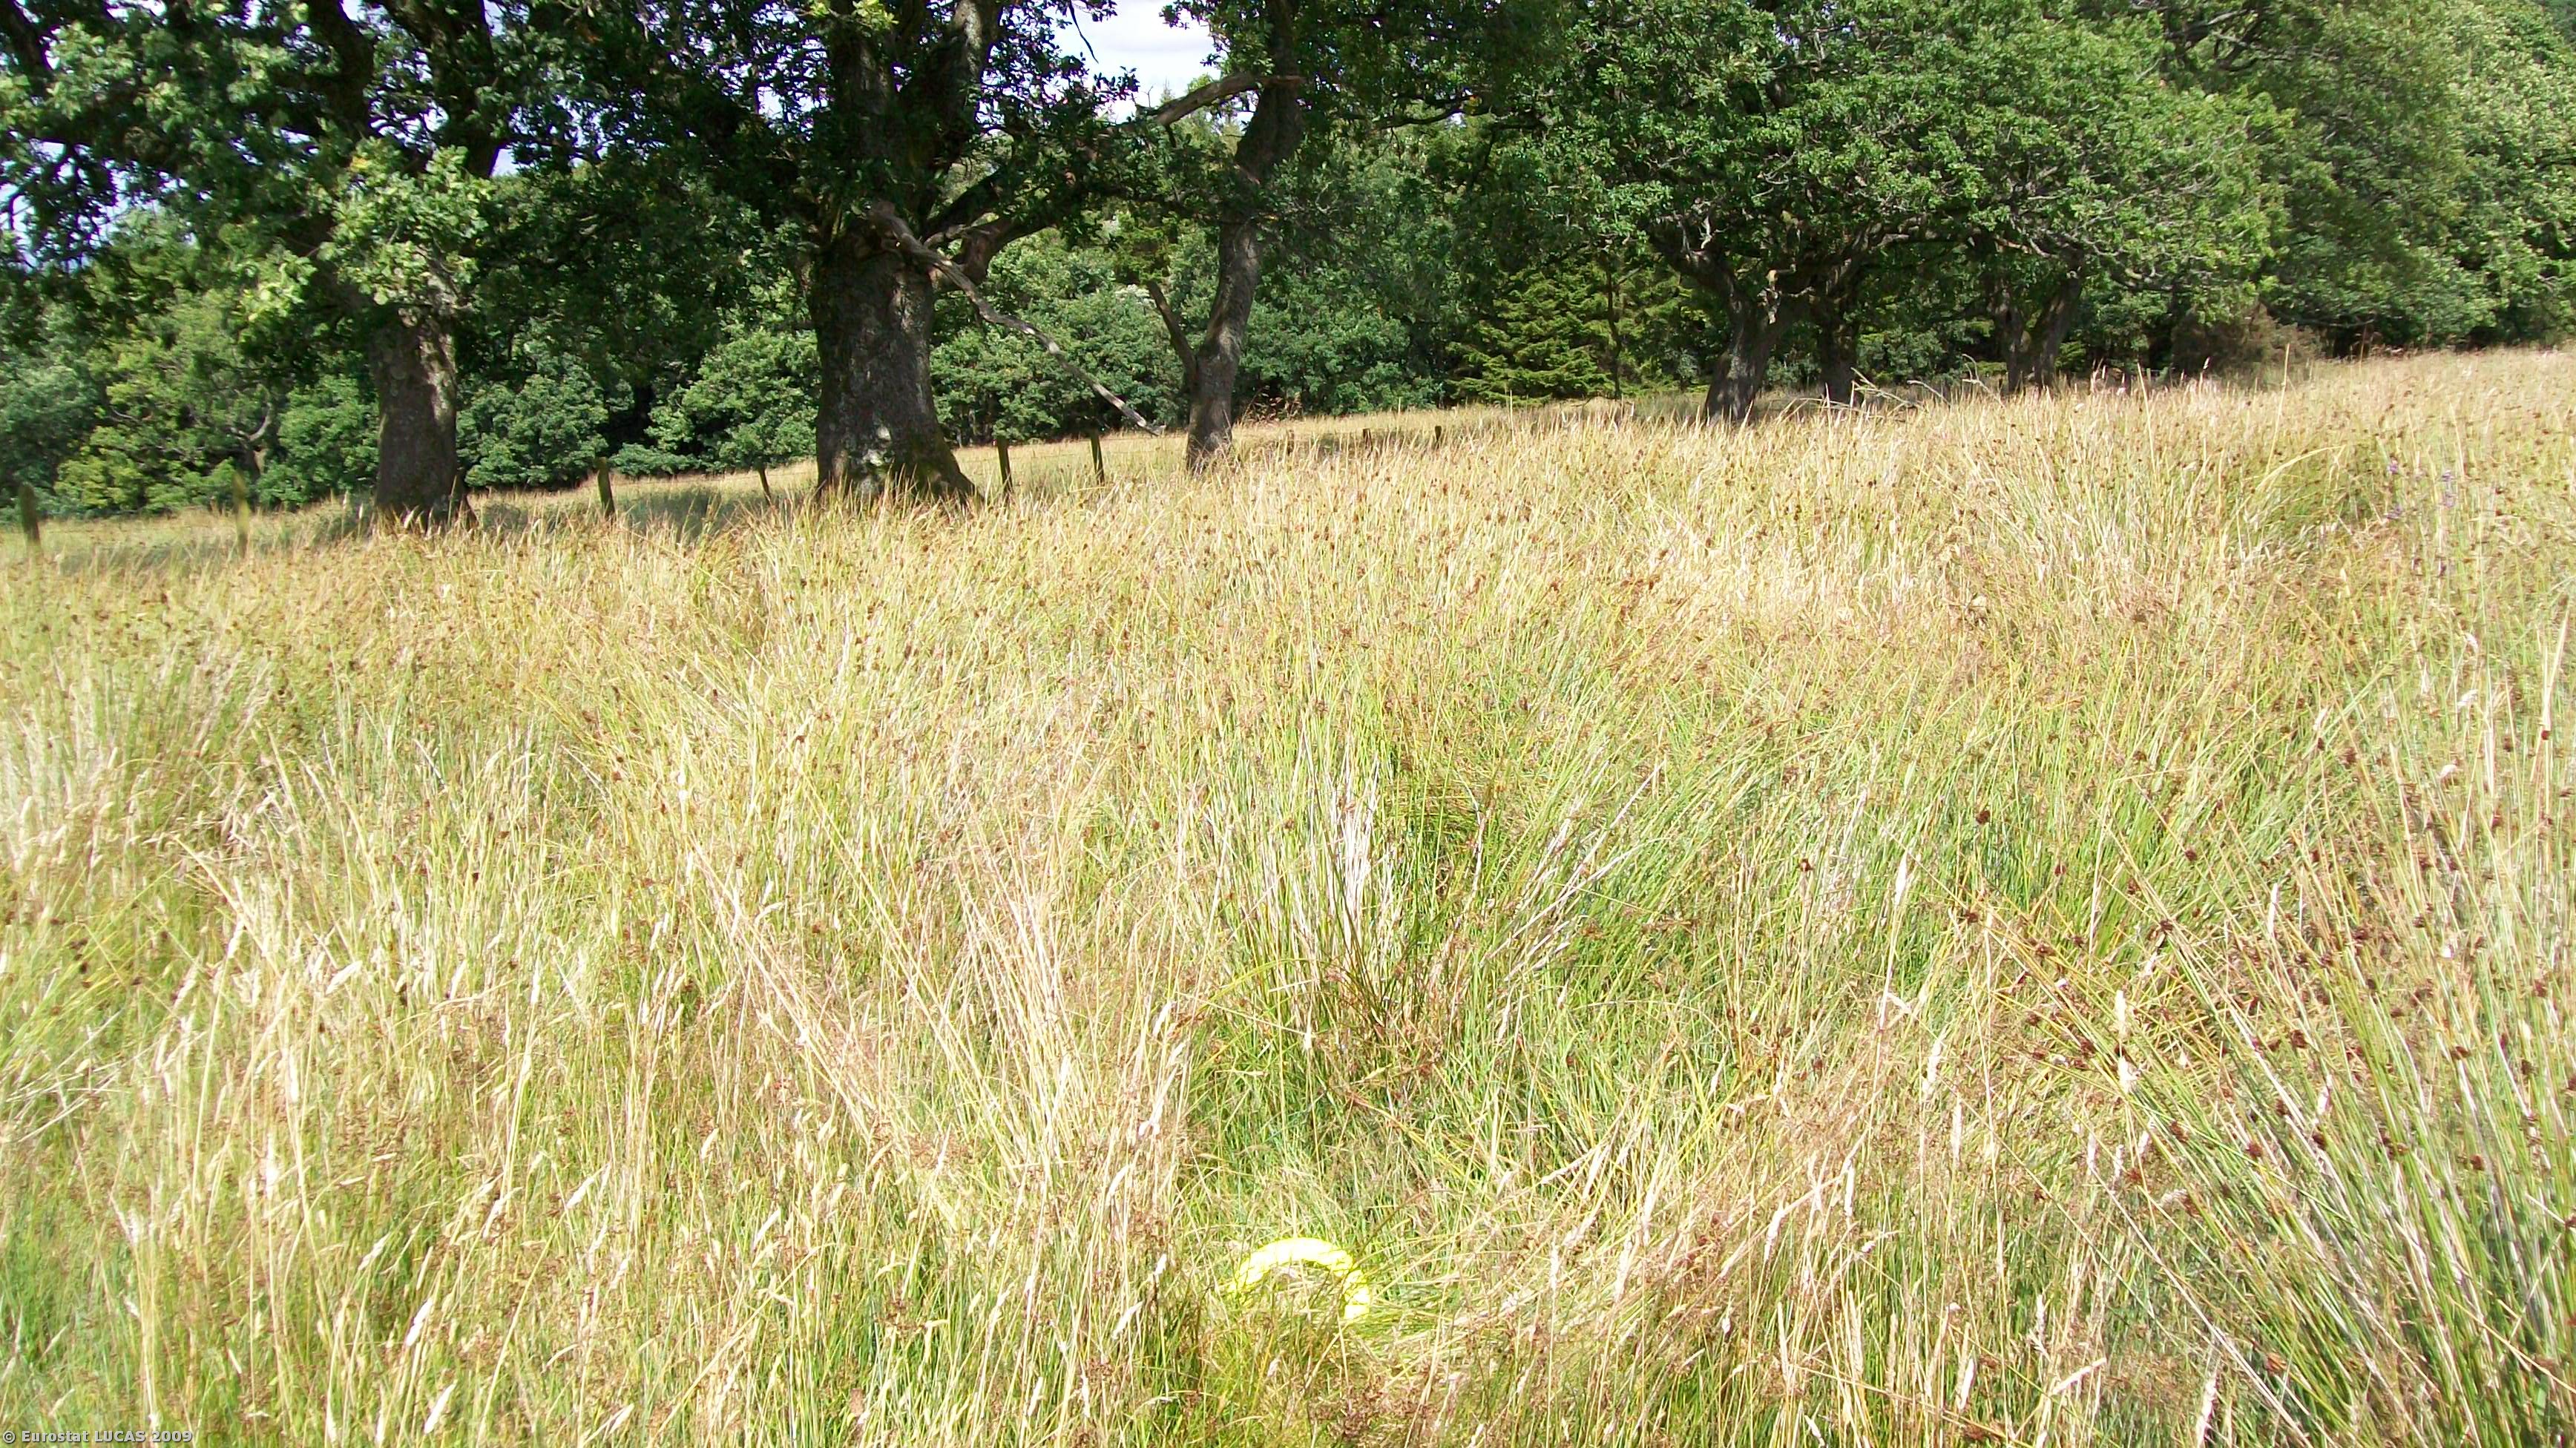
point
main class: Grassland
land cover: Grassland without tree/shrub cover
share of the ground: > 75 %
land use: Agriculture (excluding fallow land and kitchen gardens)
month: August
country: GB
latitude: 55.2082
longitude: -3.3880
